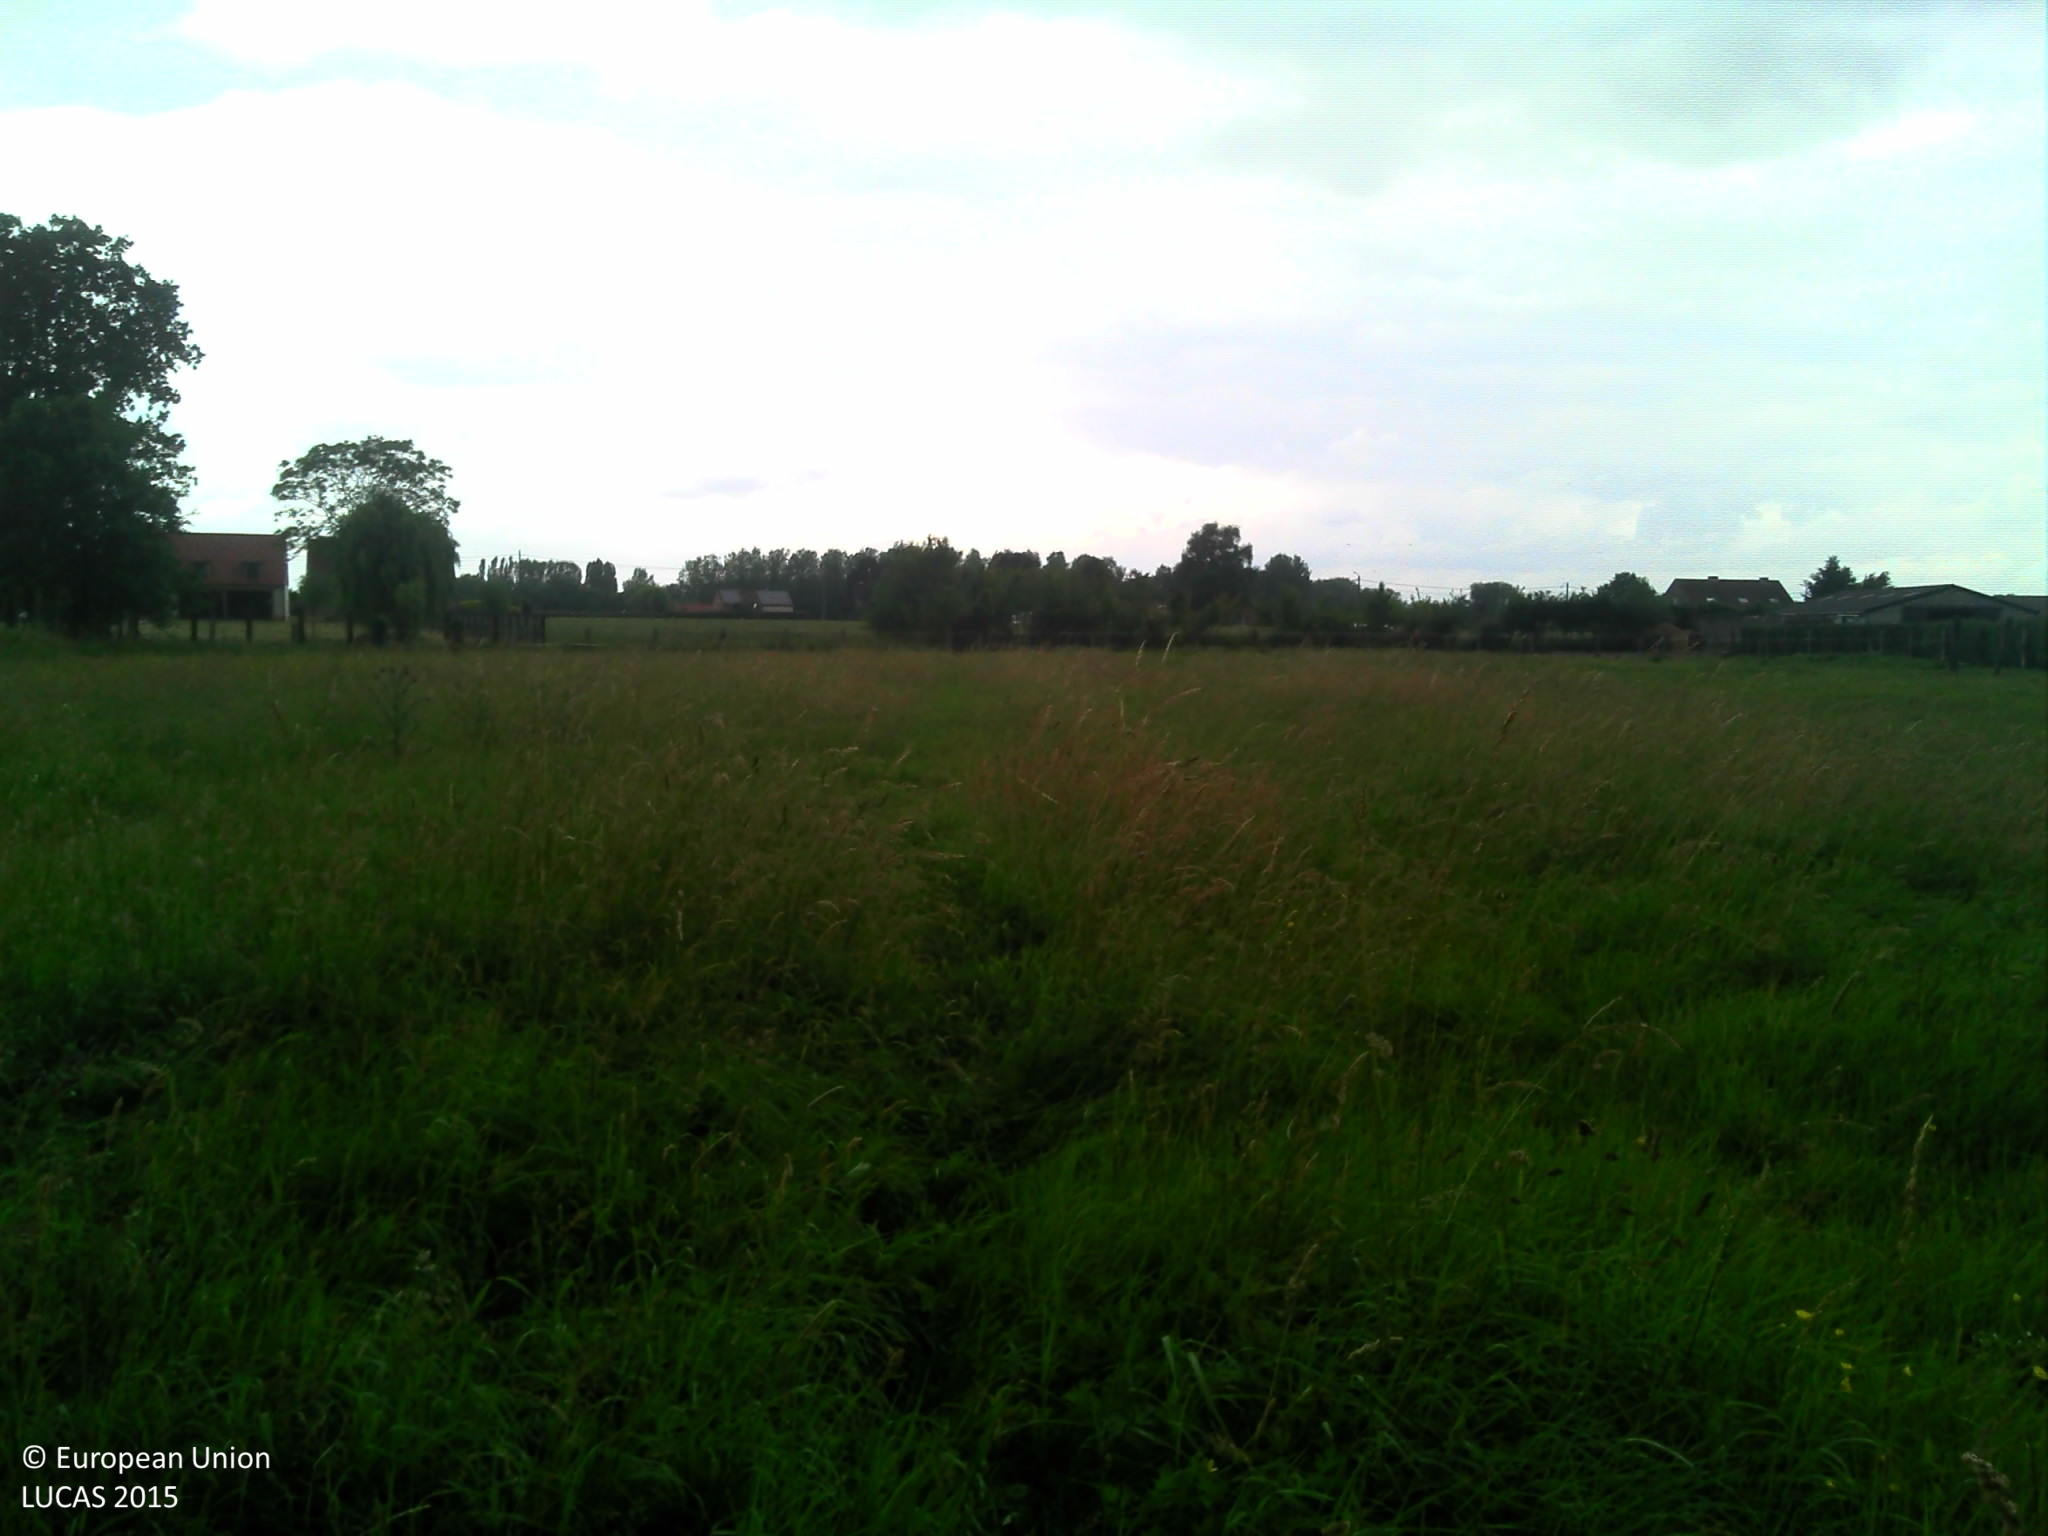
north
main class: Grassland
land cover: Grassland without tree/shrub cover
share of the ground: > 75 %
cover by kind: herbaceous plants 100 %
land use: Agriculture (excluding fallow land and kitchen gardens)
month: June
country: BE
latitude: 50.9851
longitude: 4.4257
